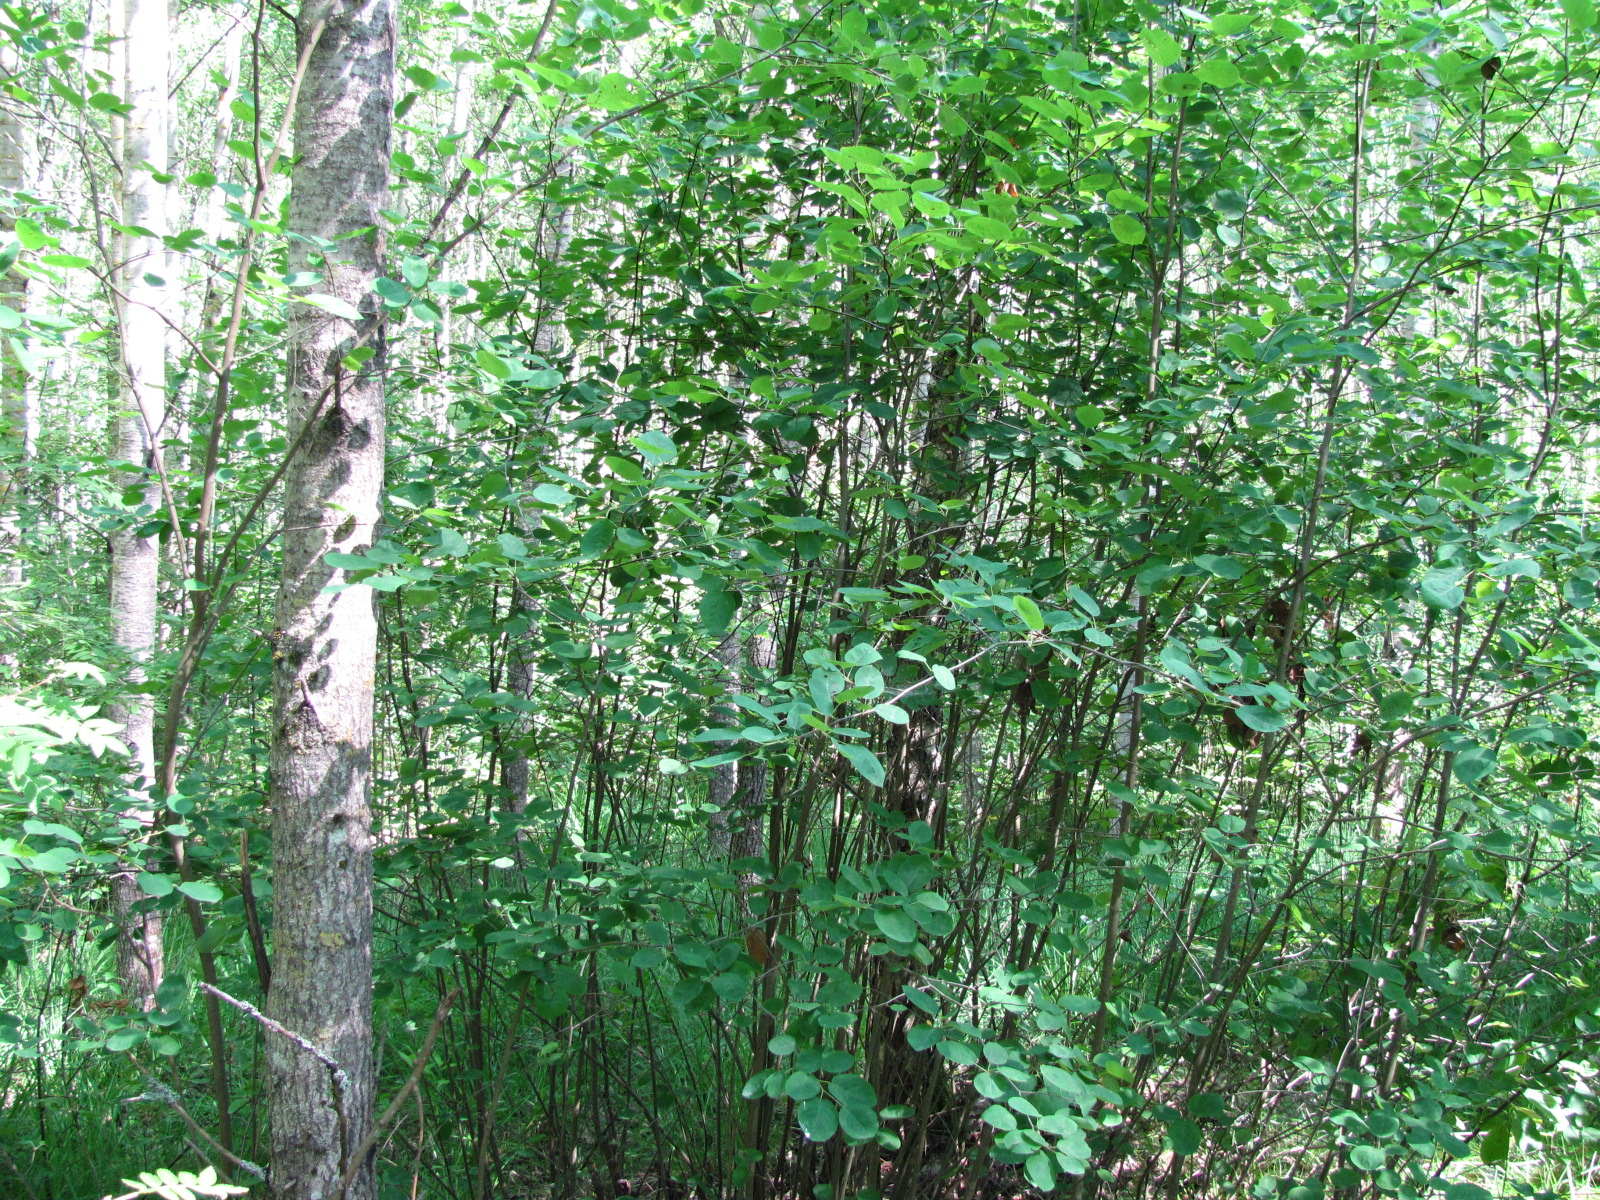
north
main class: Woodland
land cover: Pine dominated mixed woodland
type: hemiboreal forest and nemoral coniferous forest and mixed broadleaved-coniferous forest
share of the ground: > 75 %
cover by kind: coniferous forest trees 45 %, broadleaved forest trees 45 %, herbaceous plants 5 %, lichens and mosses 5 %
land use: Forestry
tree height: > 5 m
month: July
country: LV
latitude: 56.8833
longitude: 24.1176
